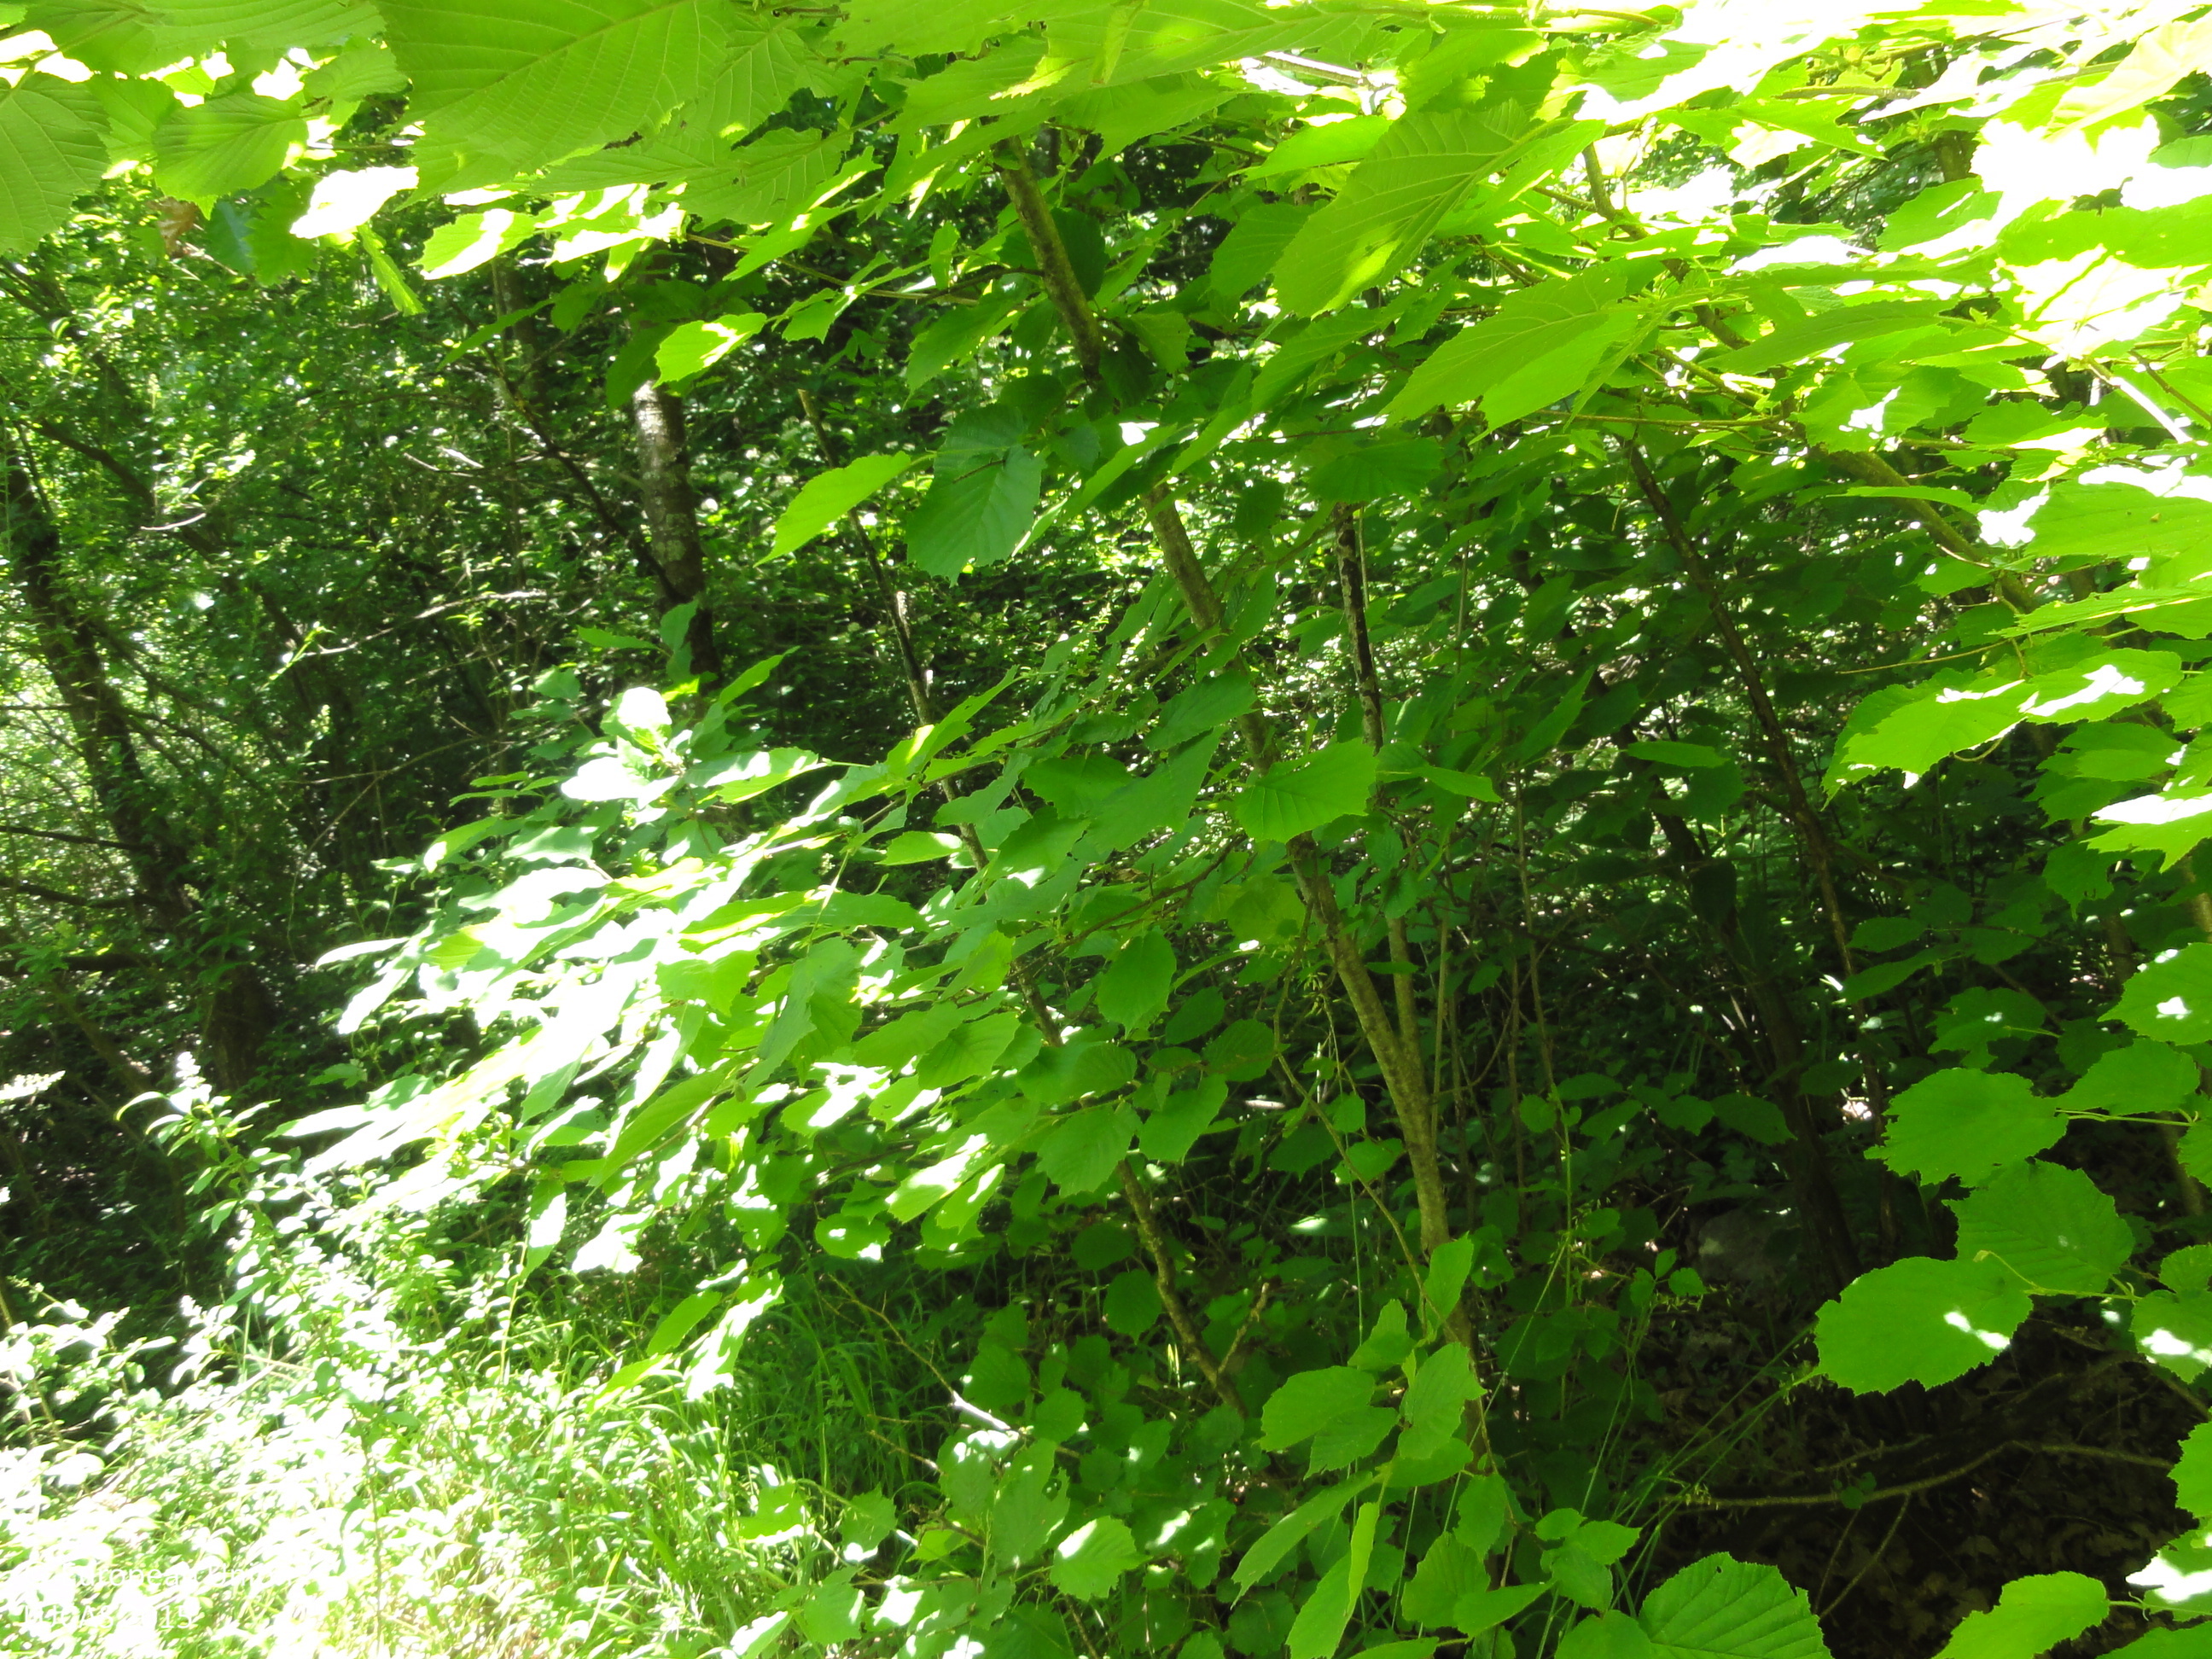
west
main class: Woodland
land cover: Broadleaved woodland
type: mesophytic deciduous forest
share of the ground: > 75 %
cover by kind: broadleaved forest trees 100 %
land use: Semi-natural and natural areas not in use
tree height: > 5 m
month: May
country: SI
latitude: 45.8730
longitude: 15.0080
